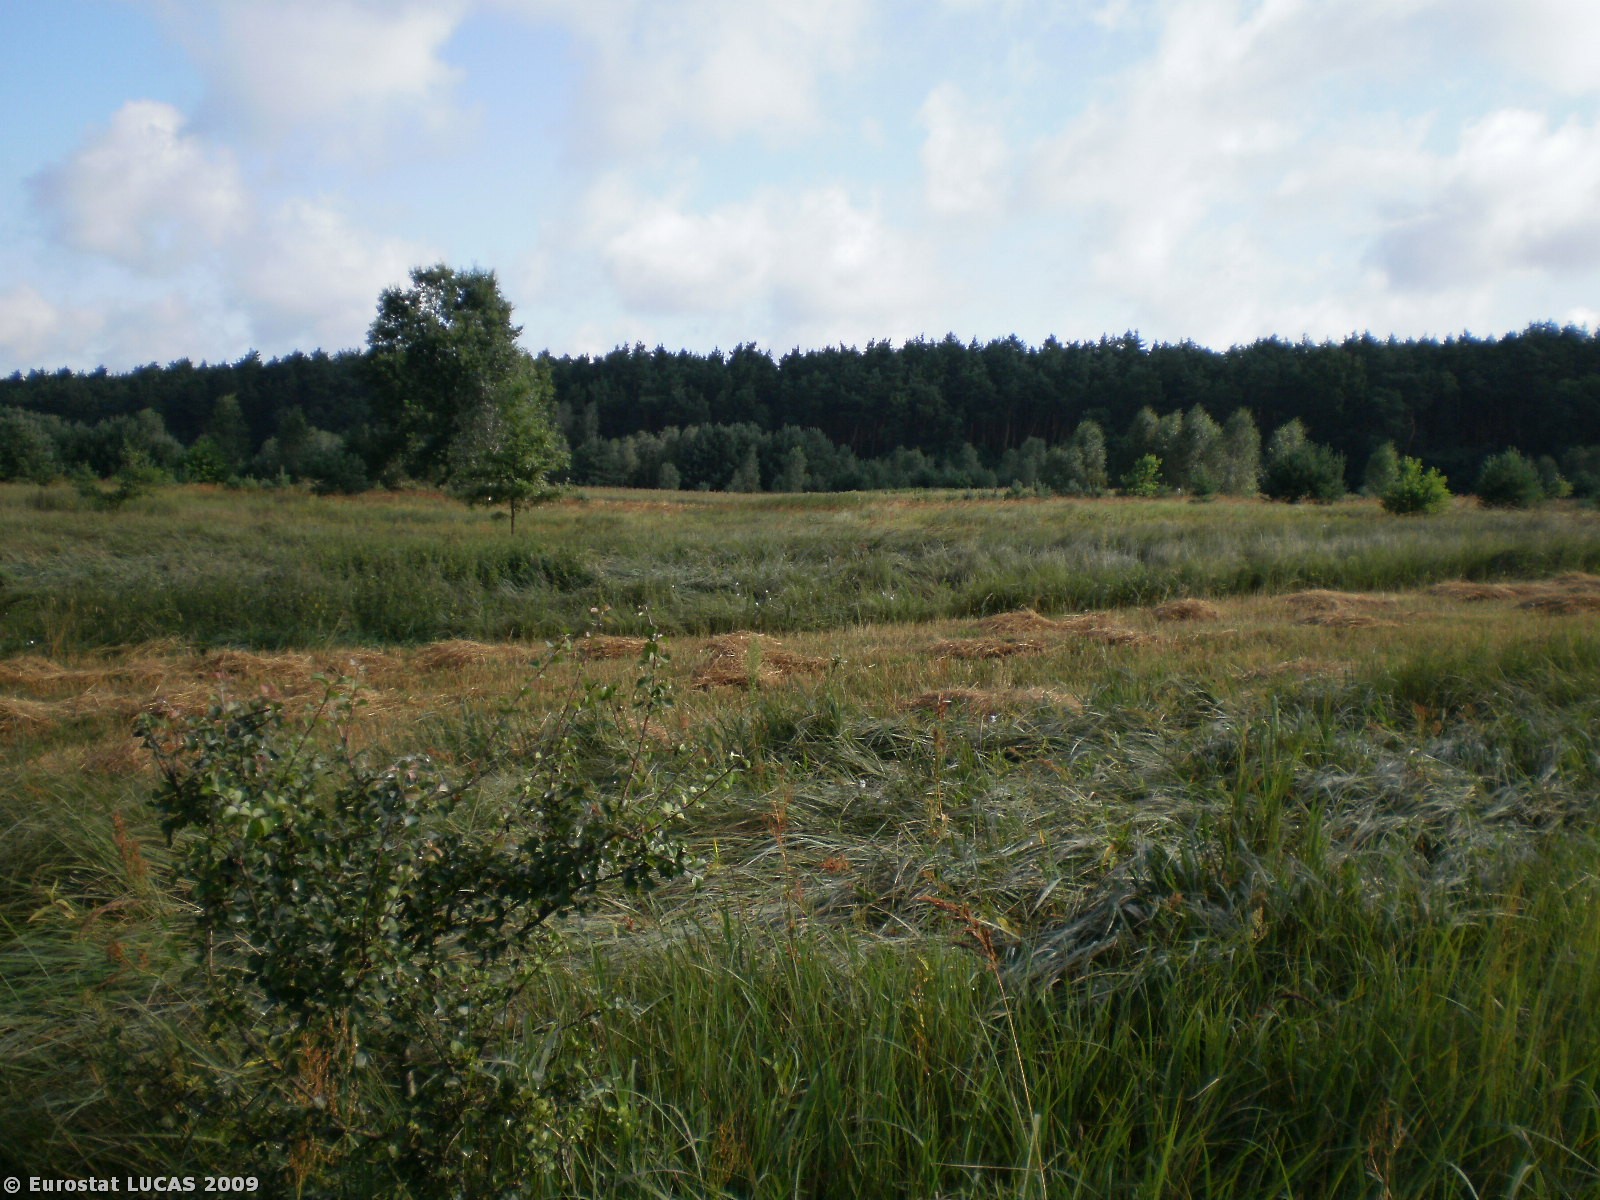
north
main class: Grassland
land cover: Grassland with sparse tree/shrub cover
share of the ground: > 75 %
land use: Nature reserves
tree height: > 5 m
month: August
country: PL
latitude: 52.7232
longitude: 21.1355
